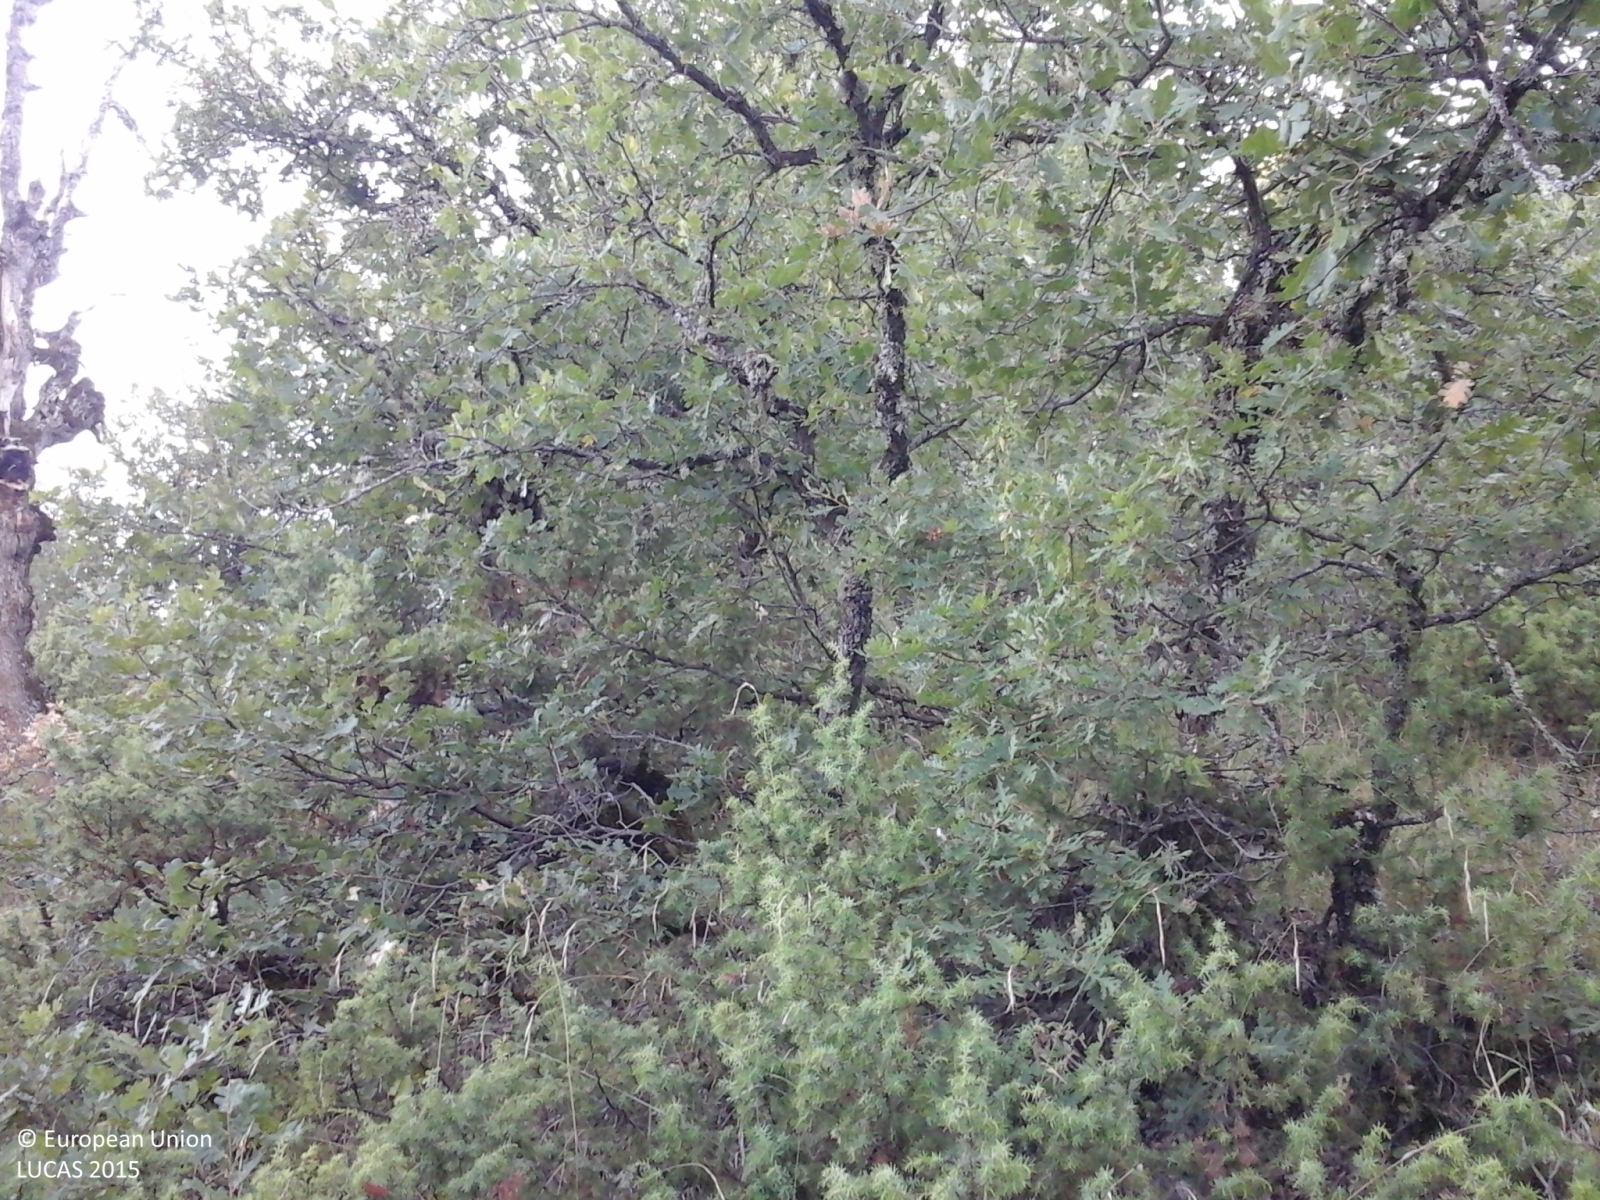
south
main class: Woodland
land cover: Broadleaved woodland
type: thermophilous deciduous forest
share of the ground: > 75 %
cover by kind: broadleaved forest trees 75 %, shrubs 15 %, herbaceous plants 5 %, unconsolidated bare surface 5 %
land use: Forestry
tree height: > 5 m
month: September
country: GR
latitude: 40.0712
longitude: 21.2771
